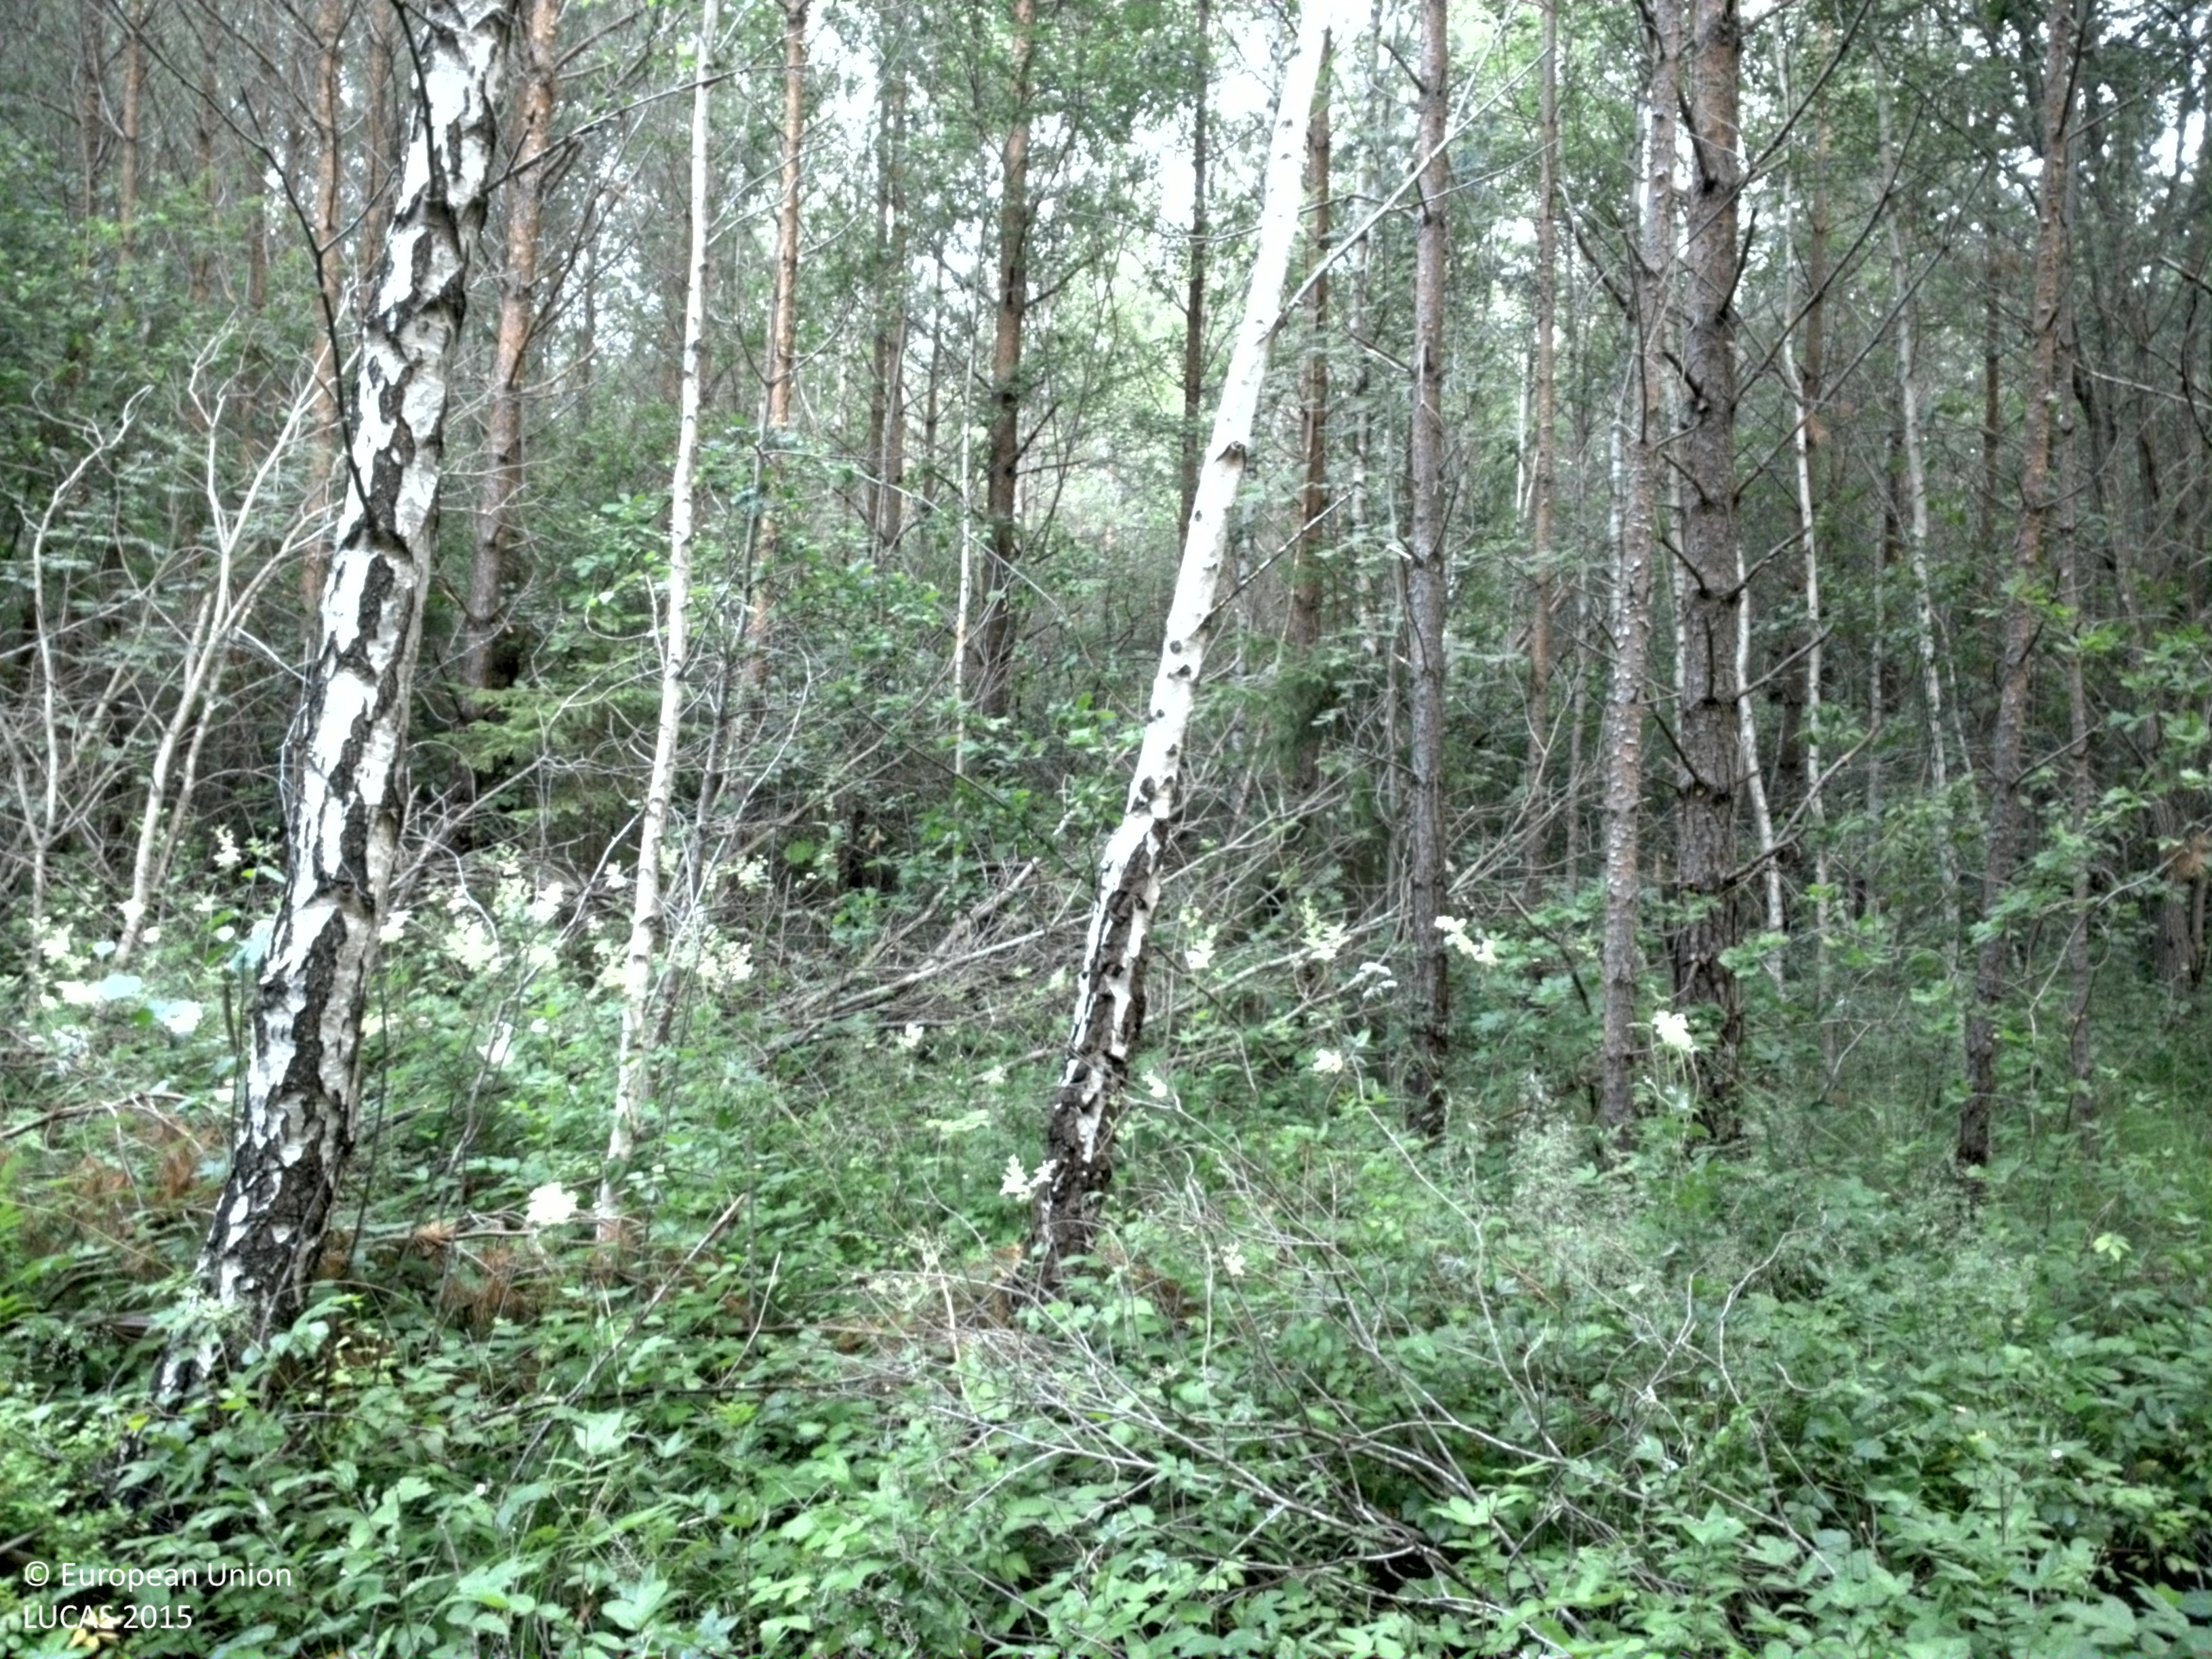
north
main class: Woodland
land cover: Pine dominated mixed woodland
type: hemiboreal forest and nemoral coniferous forest and mixed broadleaved-coniferous forest
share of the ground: > 75 %
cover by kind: coniferous forest trees 55 %, broadleaved forest trees 25 %, herbaceous plants 15 %, unconsolidated bare surface 5 %
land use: Forestry
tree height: > 5 m
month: July
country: SE
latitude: 57.4051
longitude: 18.2462
